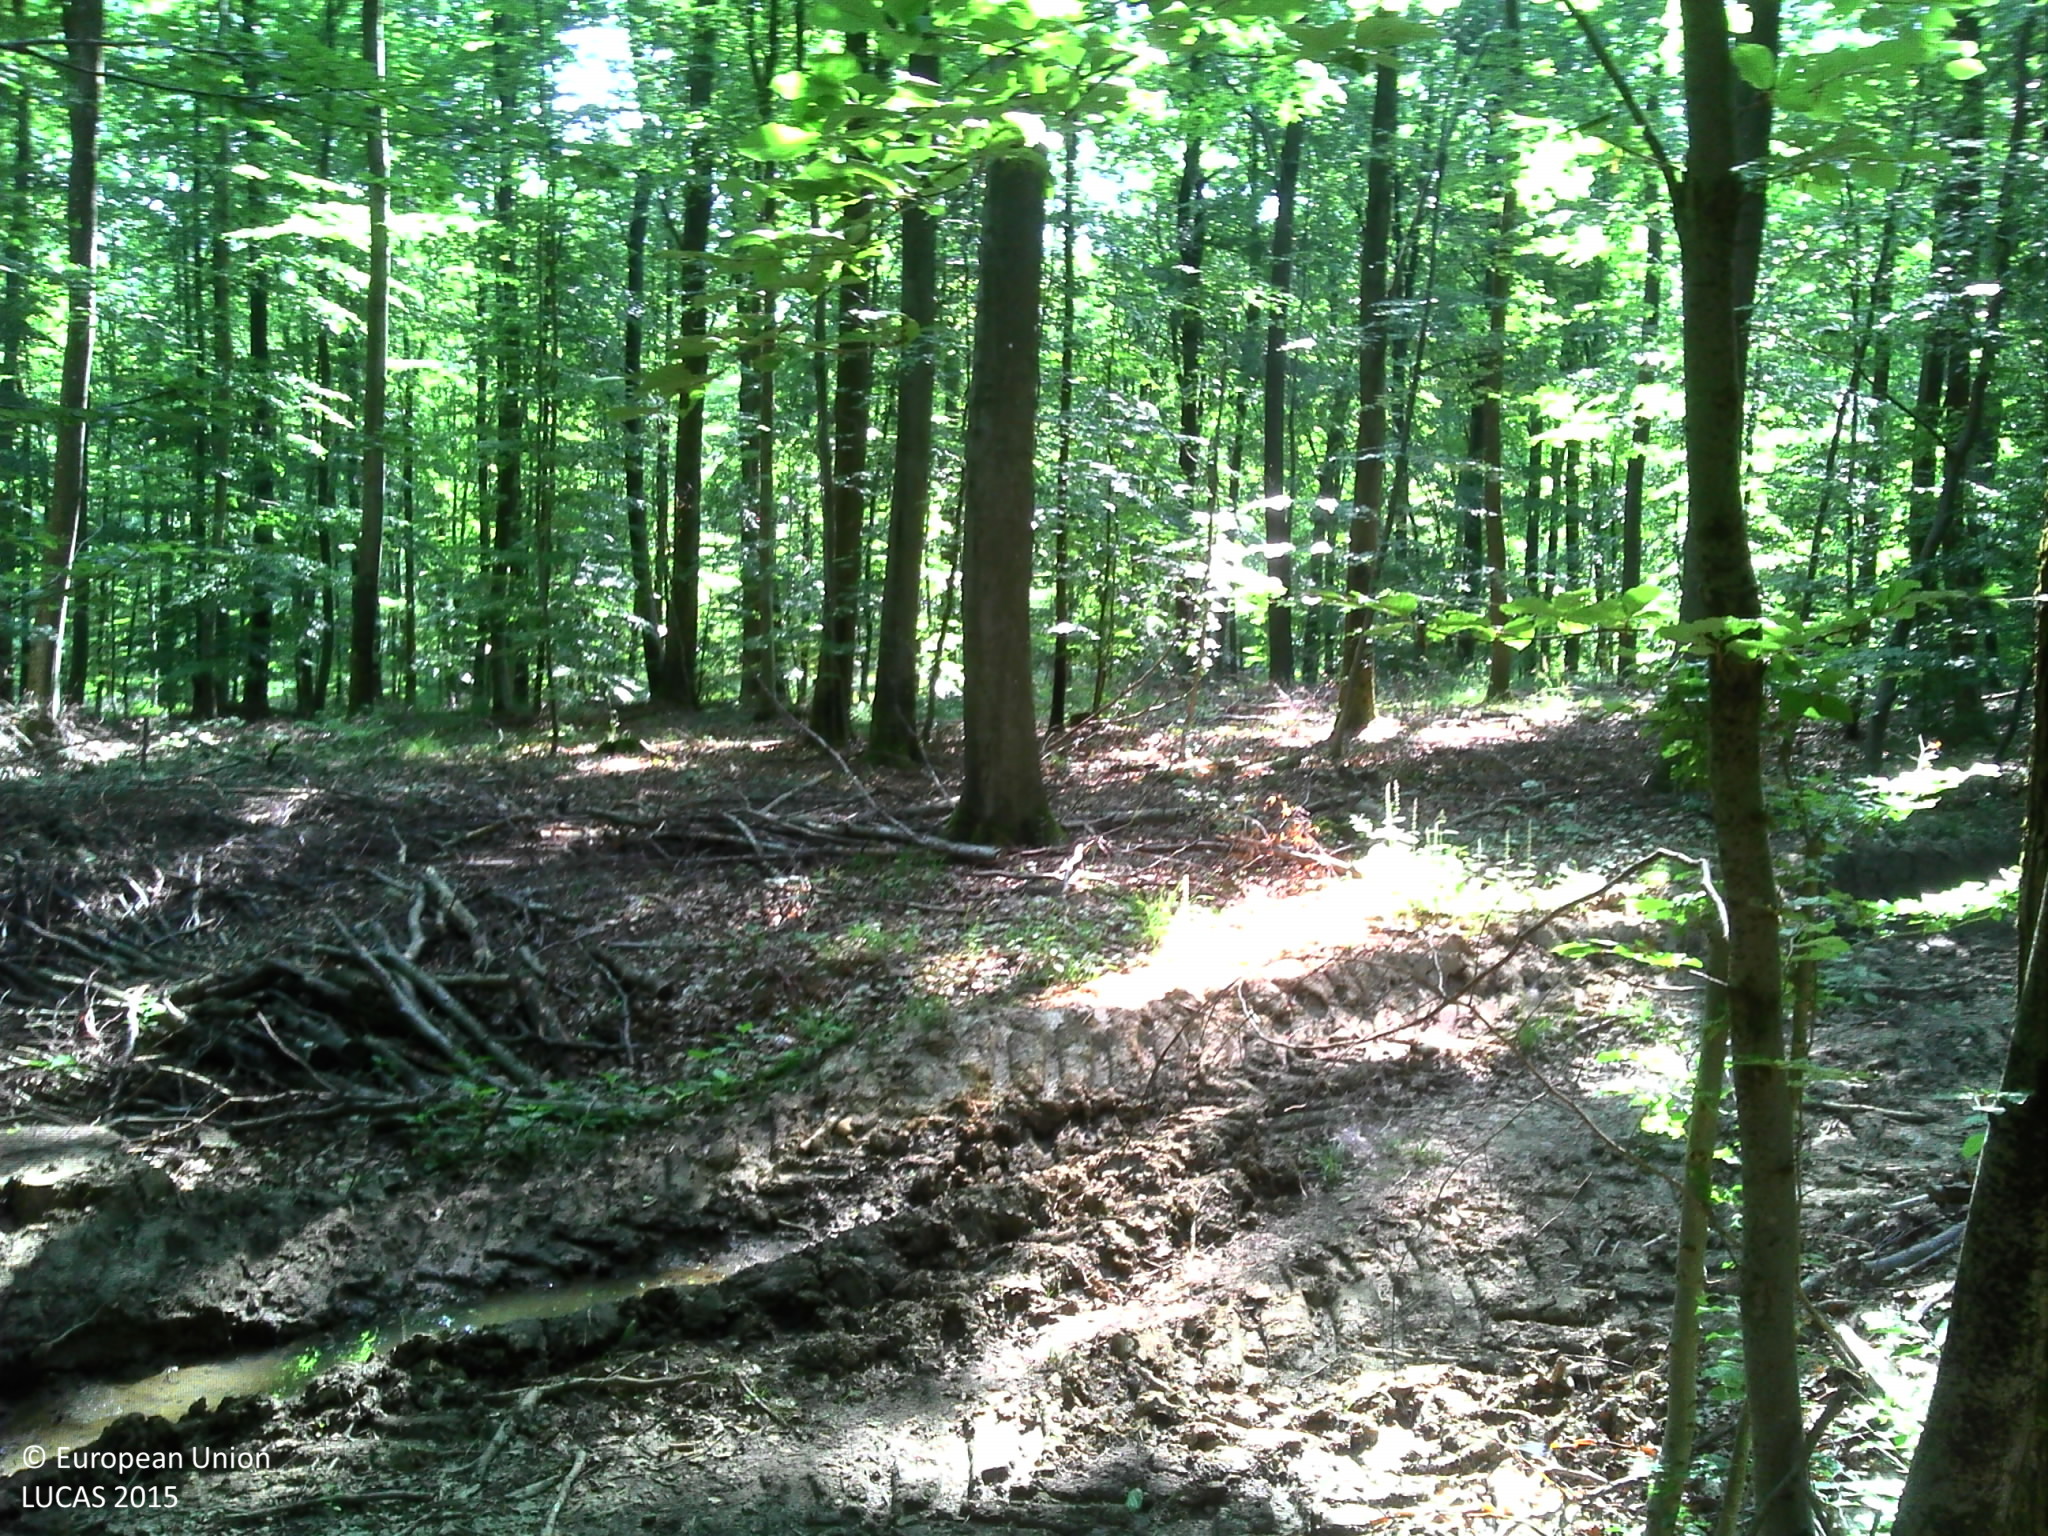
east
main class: Woodland
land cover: Broadleaved woodland
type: acidophilous oak and oak-birch forest
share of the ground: > 75 %
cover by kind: broadleaved forest trees 90 %, herbaceous plants 5 %, lichens and mosses 5 %
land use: Forestry
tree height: > 5 m
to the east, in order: Broadleaved woodland; Tracks; Broadleaved woodland; Tracks; Broadleaved woodland; Spontaneously vegetated surfaces; Tracks; Grass margins; Broadleaved woodland; Shrubland without tree cover; Broadleaved woodland
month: July
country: FR
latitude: 48.6411
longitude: 6.1050
